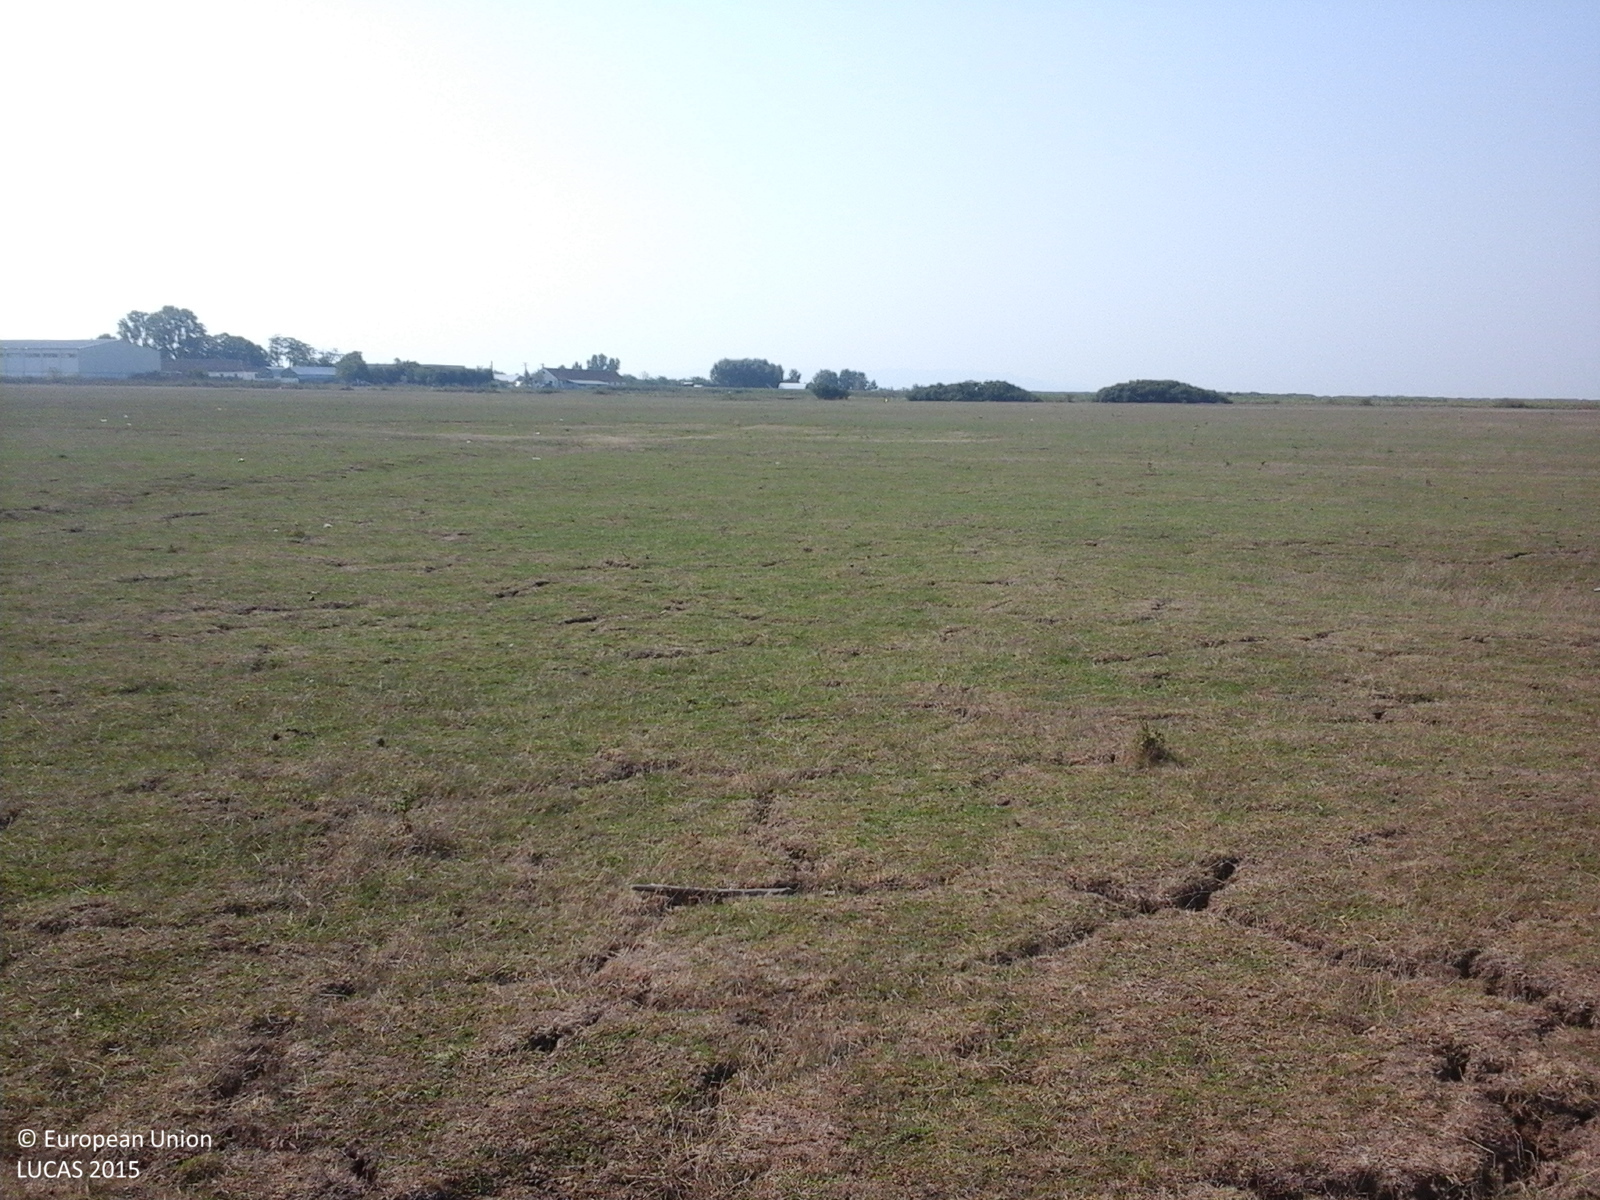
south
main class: Grassland
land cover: Grassland without tree/shrub cover
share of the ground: > 75 %
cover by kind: herbaceous plants 100 %
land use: Agriculture (excluding fallow land and kitchen gardens)
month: August
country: RO
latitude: 46.4711
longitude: 21.6960
